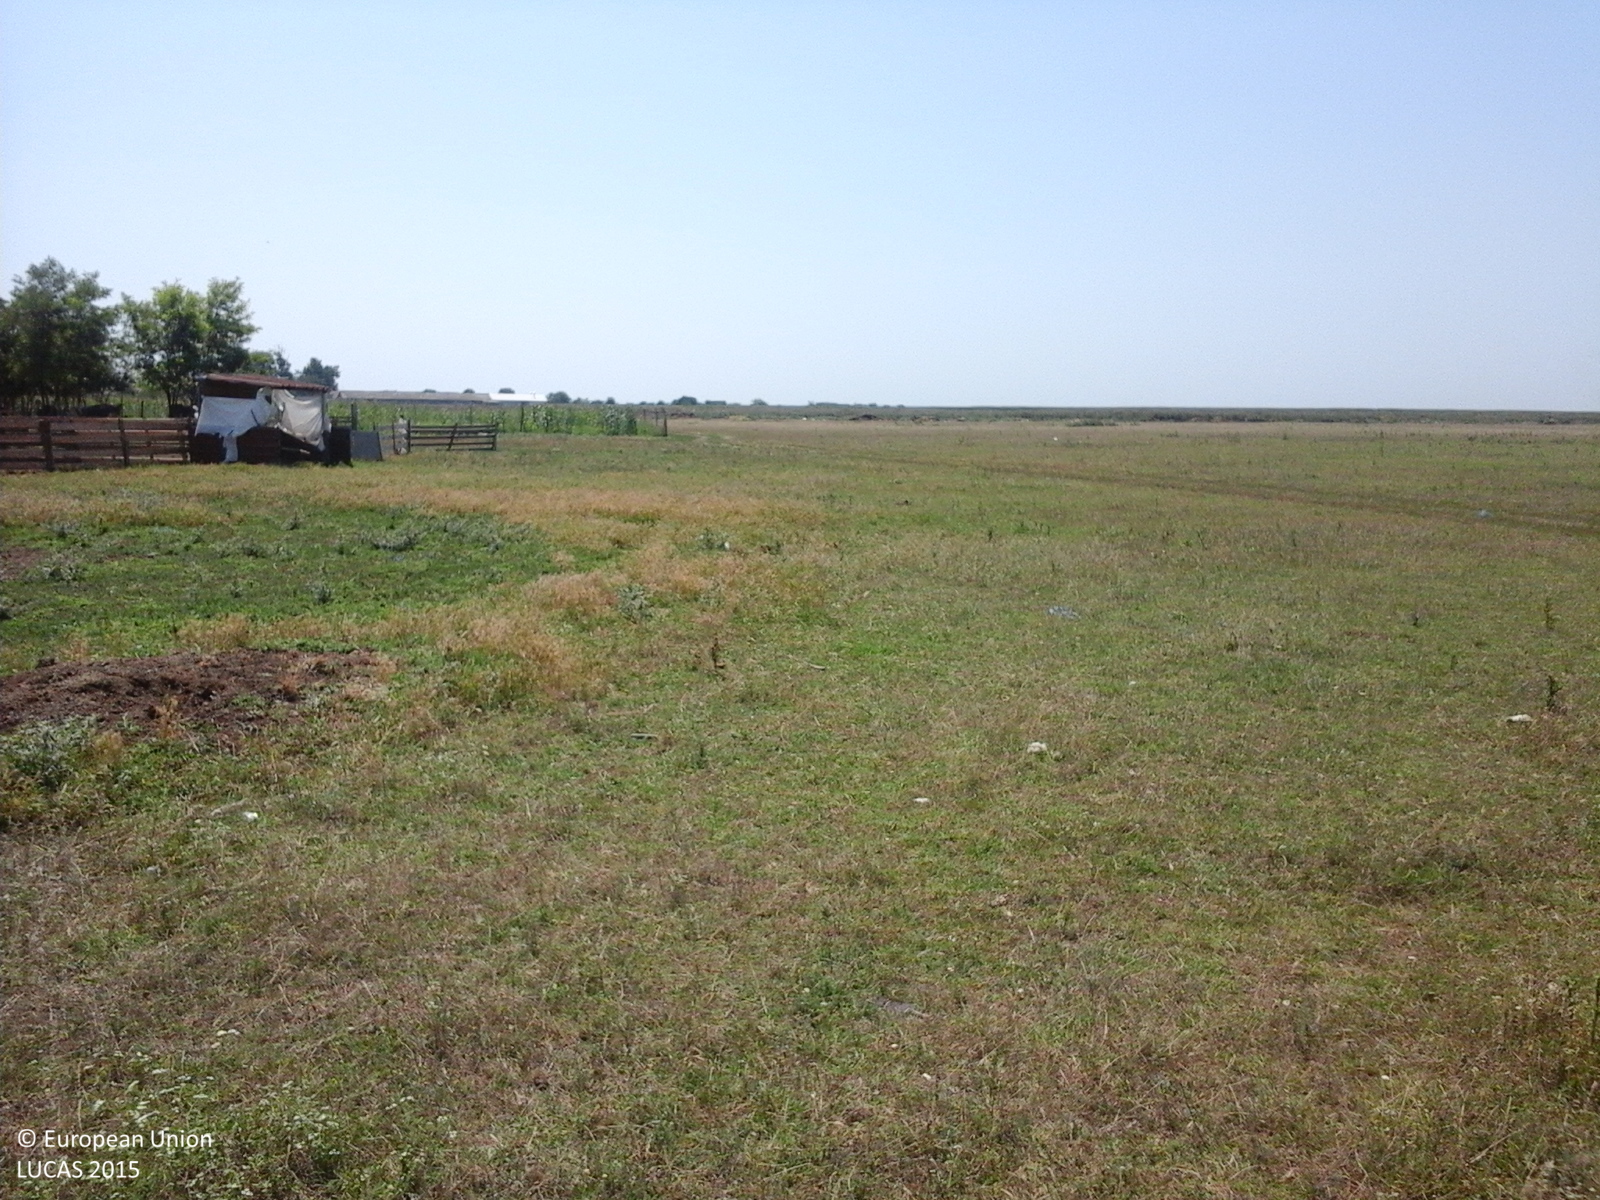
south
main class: Grassland
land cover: Grassland without tree/shrub cover
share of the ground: > 75 %
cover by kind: herbaceous plants 100 %
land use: Agriculture (excluding fallow land and kitchen gardens)
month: July
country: RO
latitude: 44.7292
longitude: 26.8317
